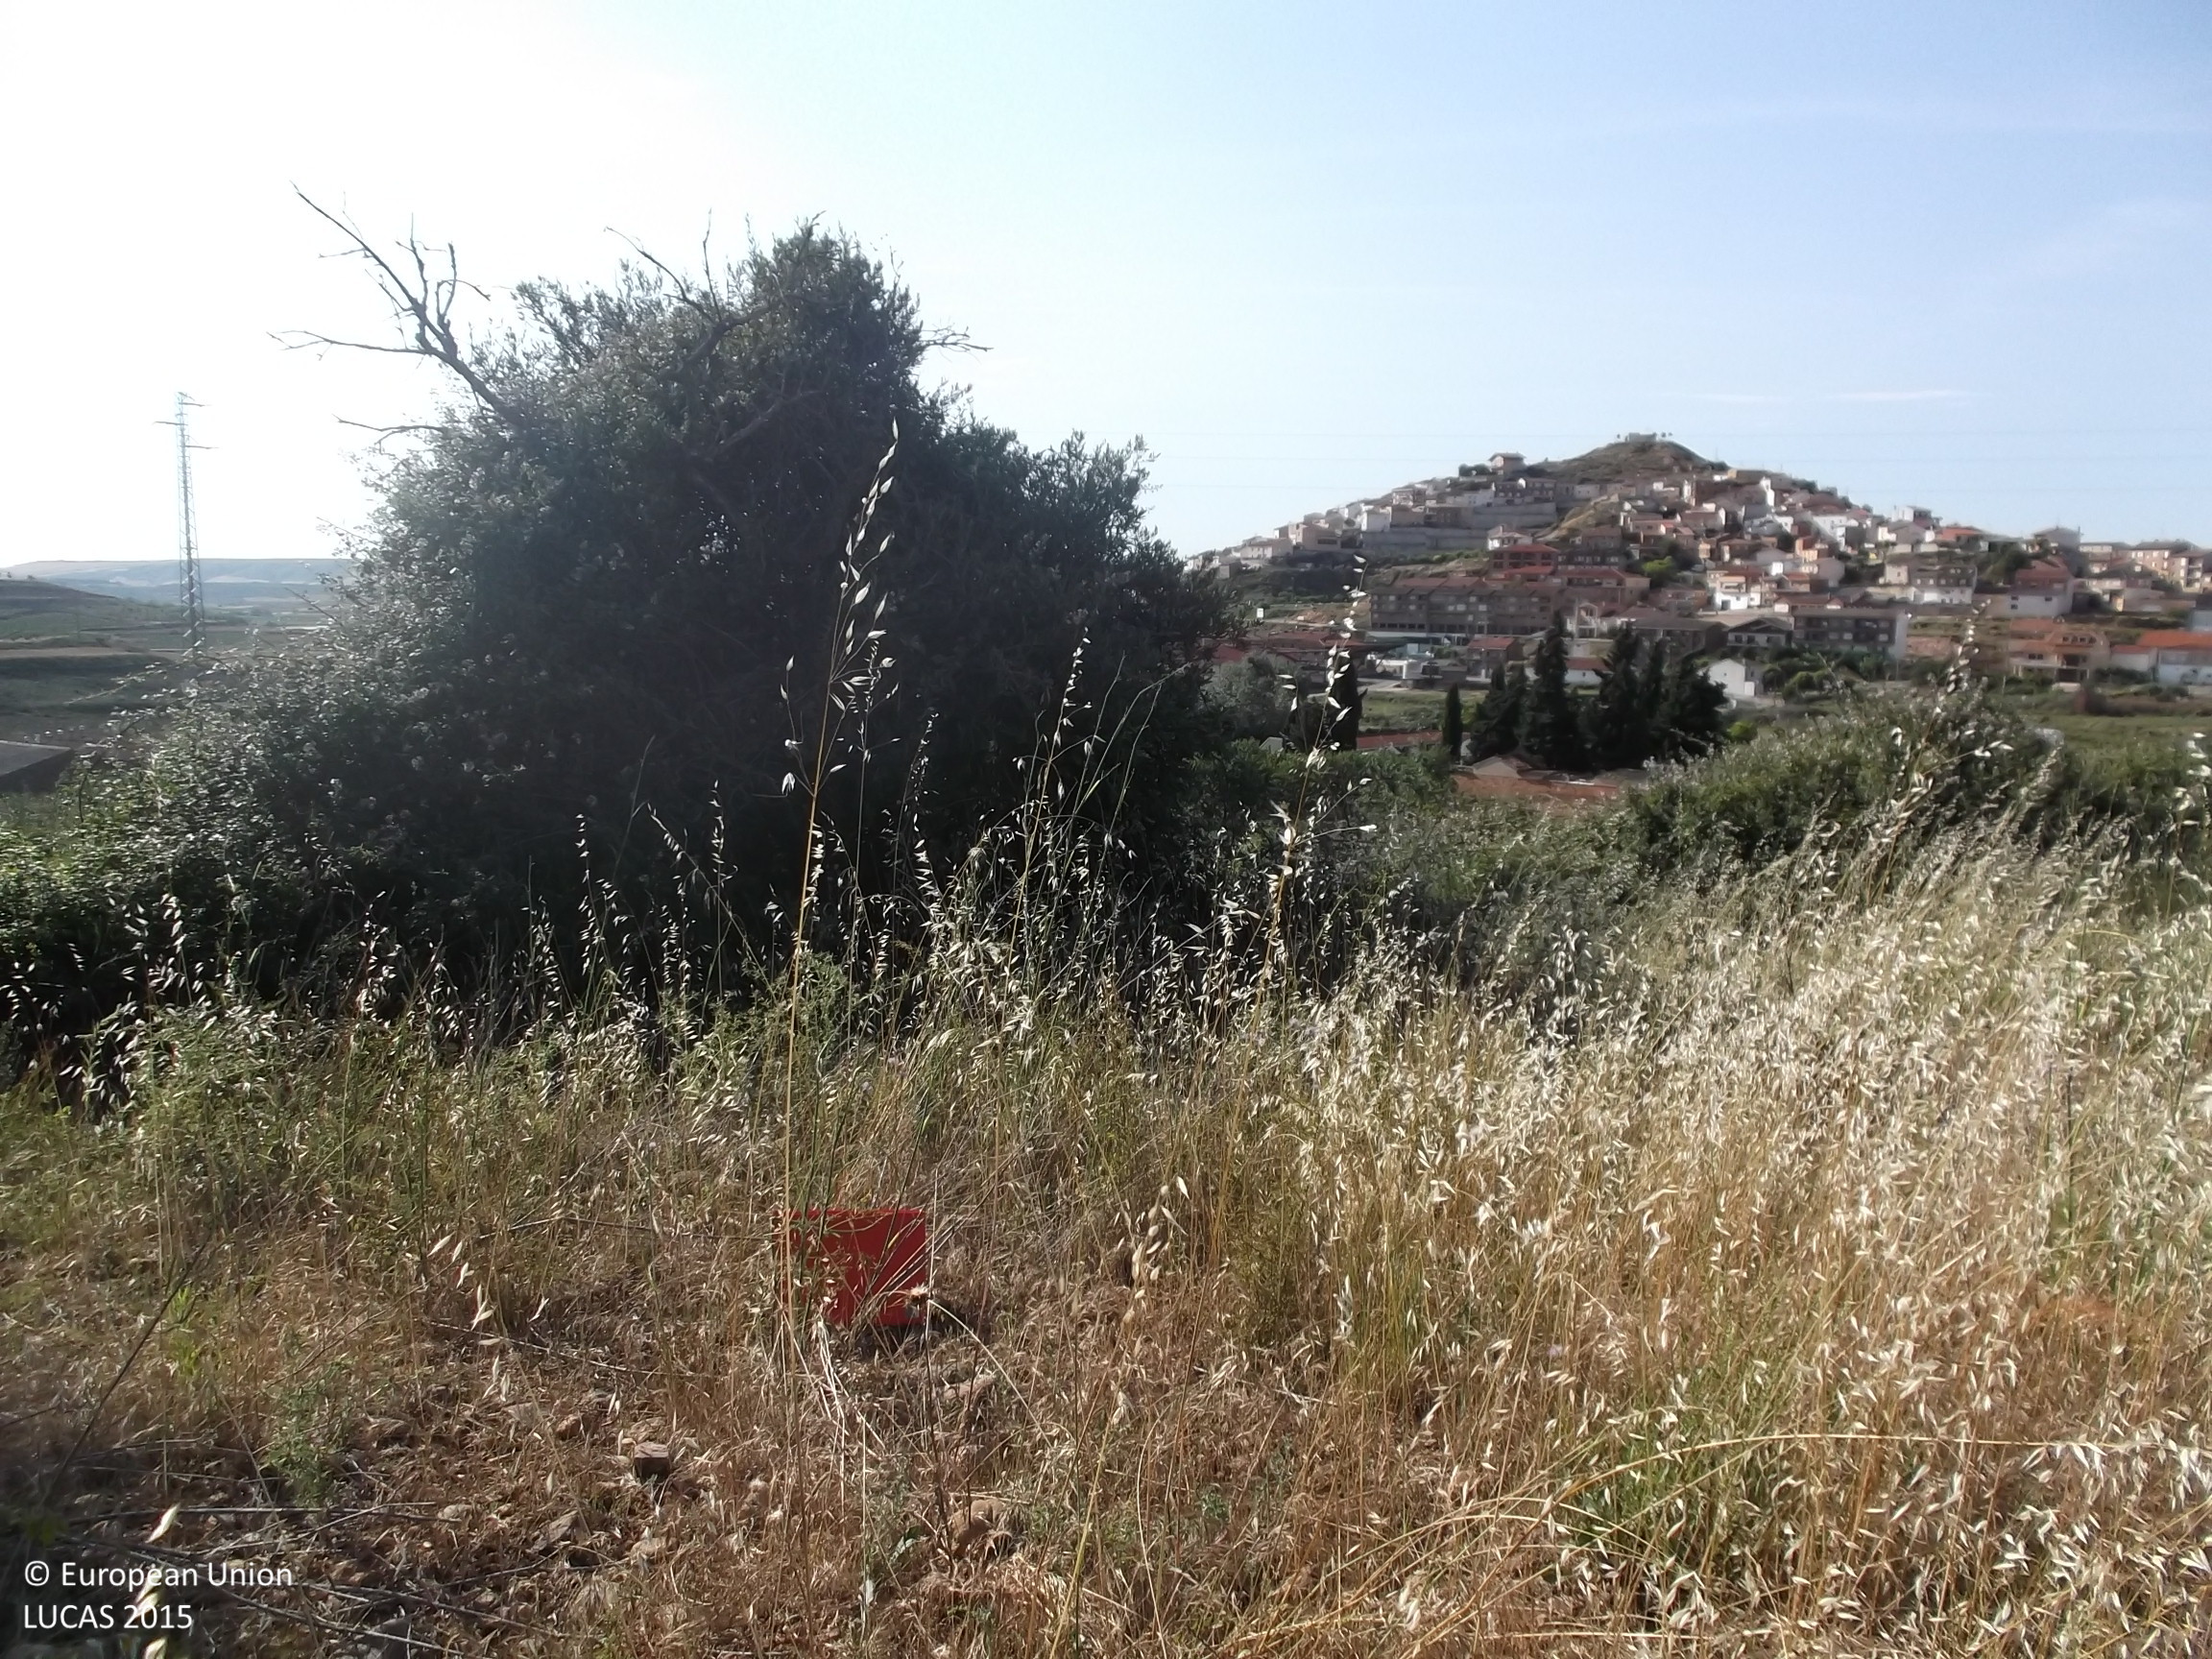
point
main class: Grassland
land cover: Spontaneously vegetated surfaces
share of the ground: > 75 %
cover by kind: herbaceous plants 90 %, unconsolidated bare surface 5 %
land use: Fallow land
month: June
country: ES
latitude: 42.3374
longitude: -2.1653
